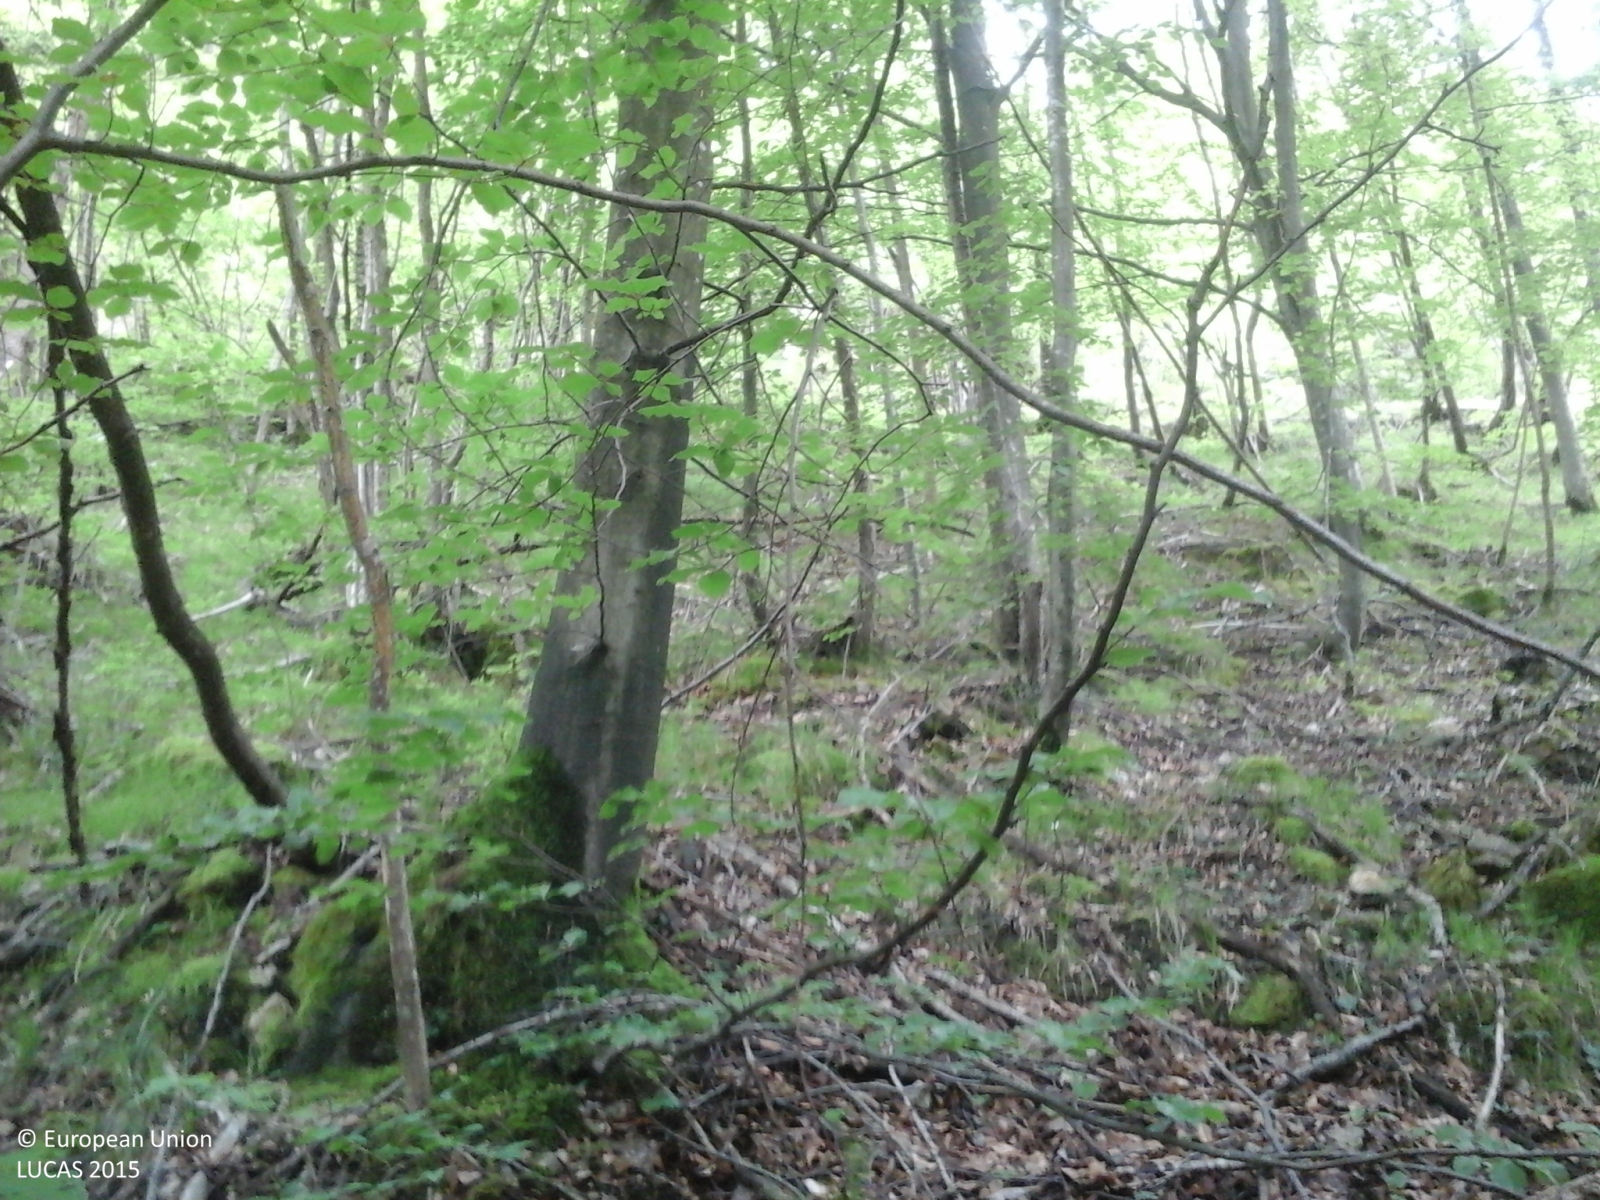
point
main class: Woodland
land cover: Broadleaved woodland
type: mesophytic deciduous forest
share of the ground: > 75 %
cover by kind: broadleaved forest trees 100 %
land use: Forestry
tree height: > 5 m
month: May
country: IT
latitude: 45.8214
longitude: 11.2466
